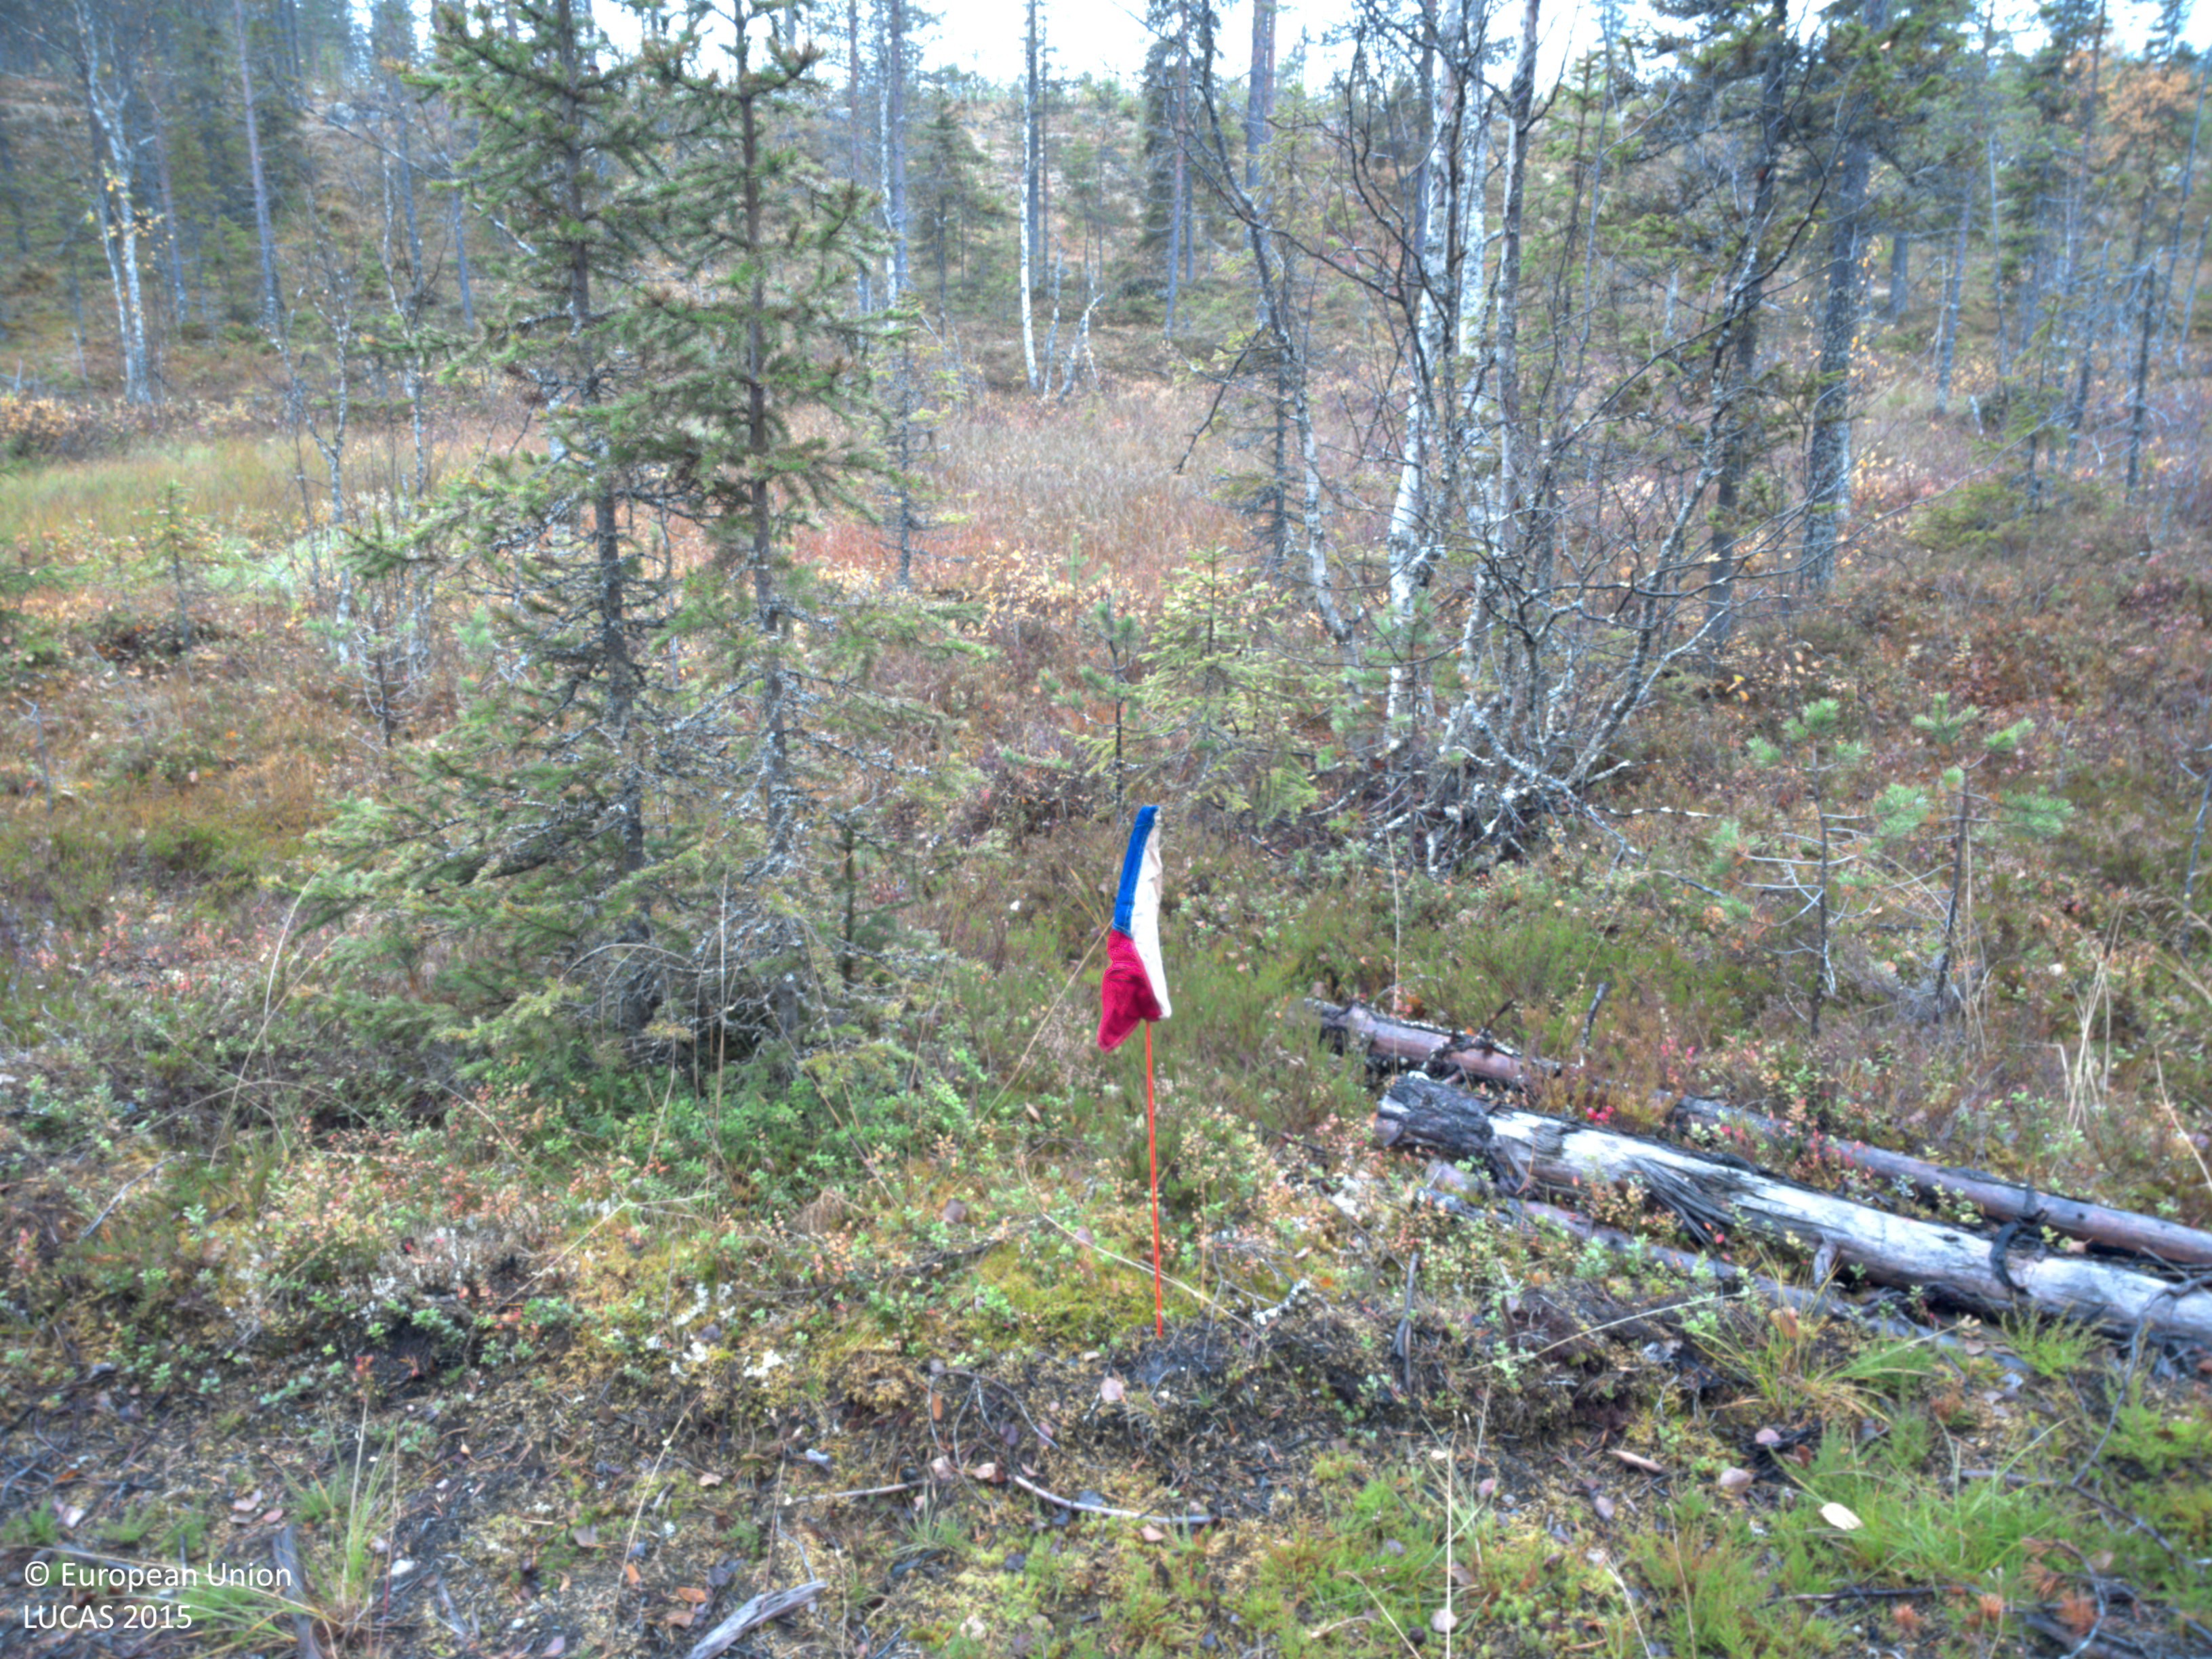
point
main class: Woodland
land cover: Spruce dominated mixed woodland
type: boreal forest
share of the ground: 25 - 50 %
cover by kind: coniferous forest trees 30 %, shrubs 30 %, broadleaved forest trees 20 %, herbaceous plants 10 %, lichens and mosses 10 %
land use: Forestry
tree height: < 5 m
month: September
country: SE
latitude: 64.8986
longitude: 18.8179
